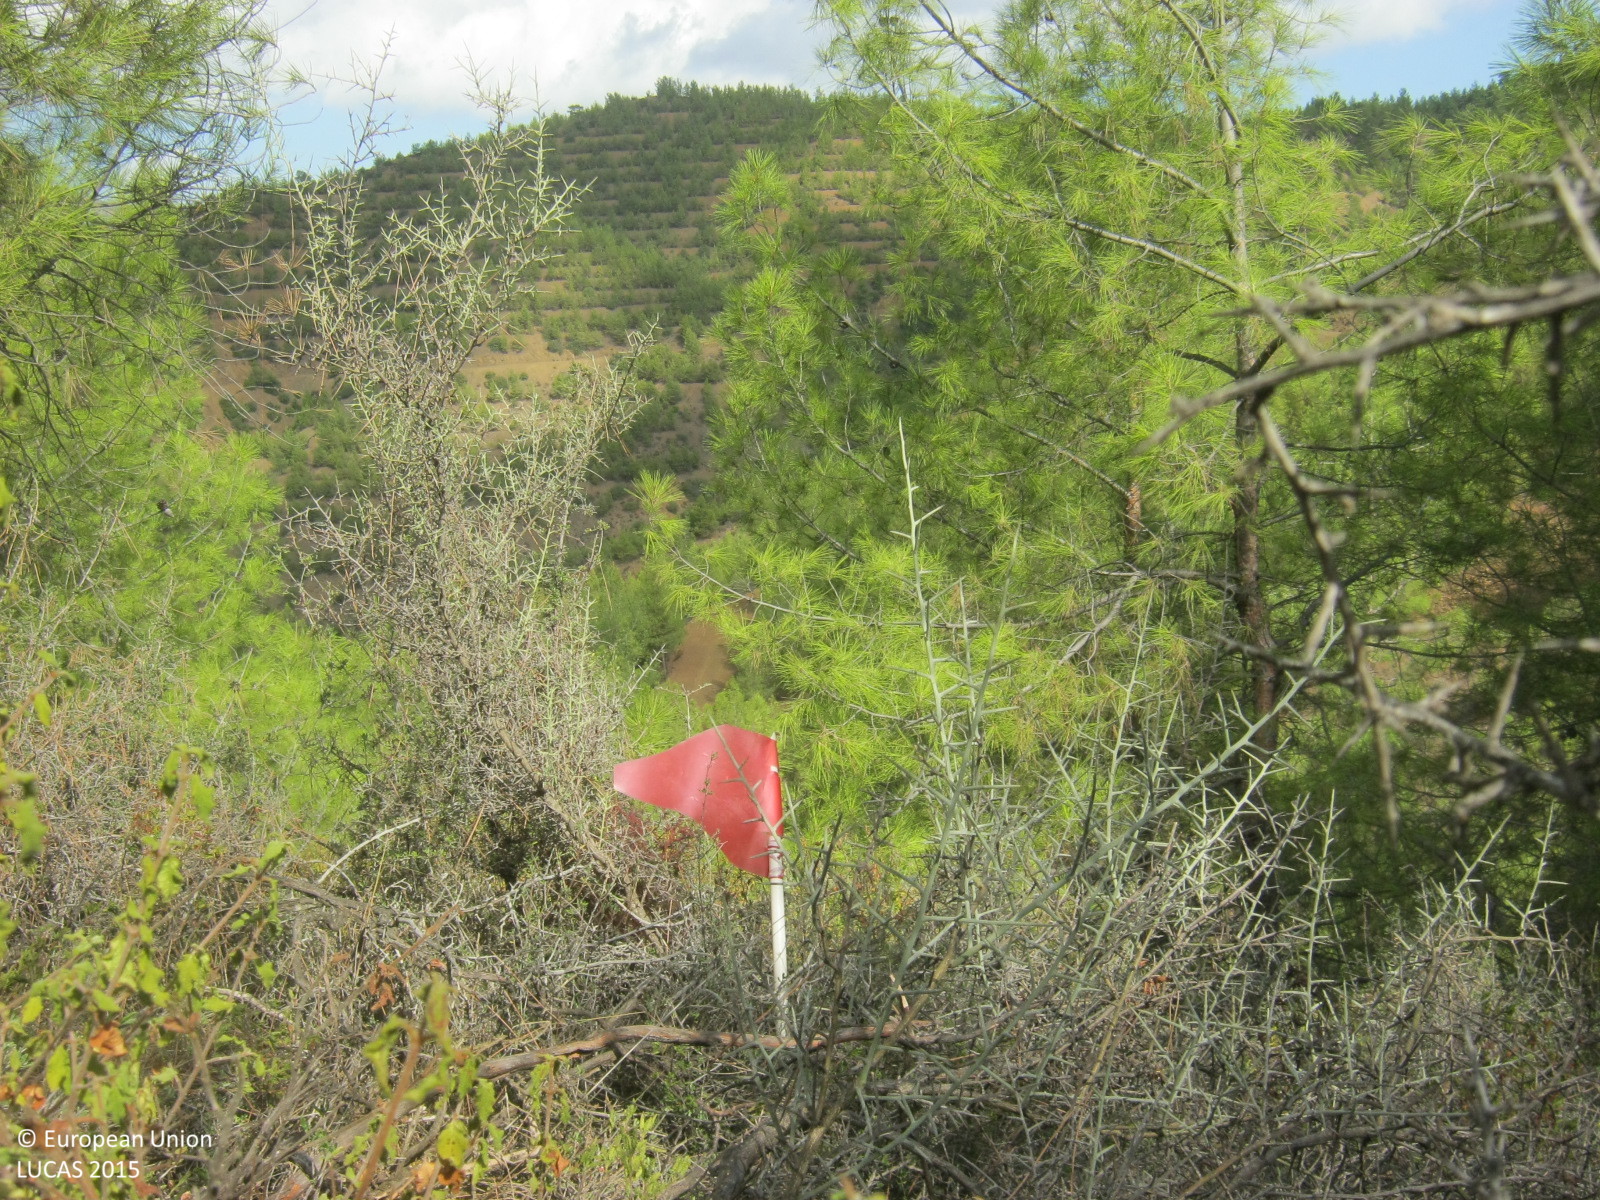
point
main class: Woodland
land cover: Pine dominated coniferous woodland
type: coniferous forest of the mediterranean region
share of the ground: > 75 %
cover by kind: coniferous forest trees 75 %, shrubs 15 %, herbaceous plants 5 %, unconsolidated bare surface 5 %
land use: Forestry
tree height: > 5 m
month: September
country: CY
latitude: 35.0492
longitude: 32.8073
